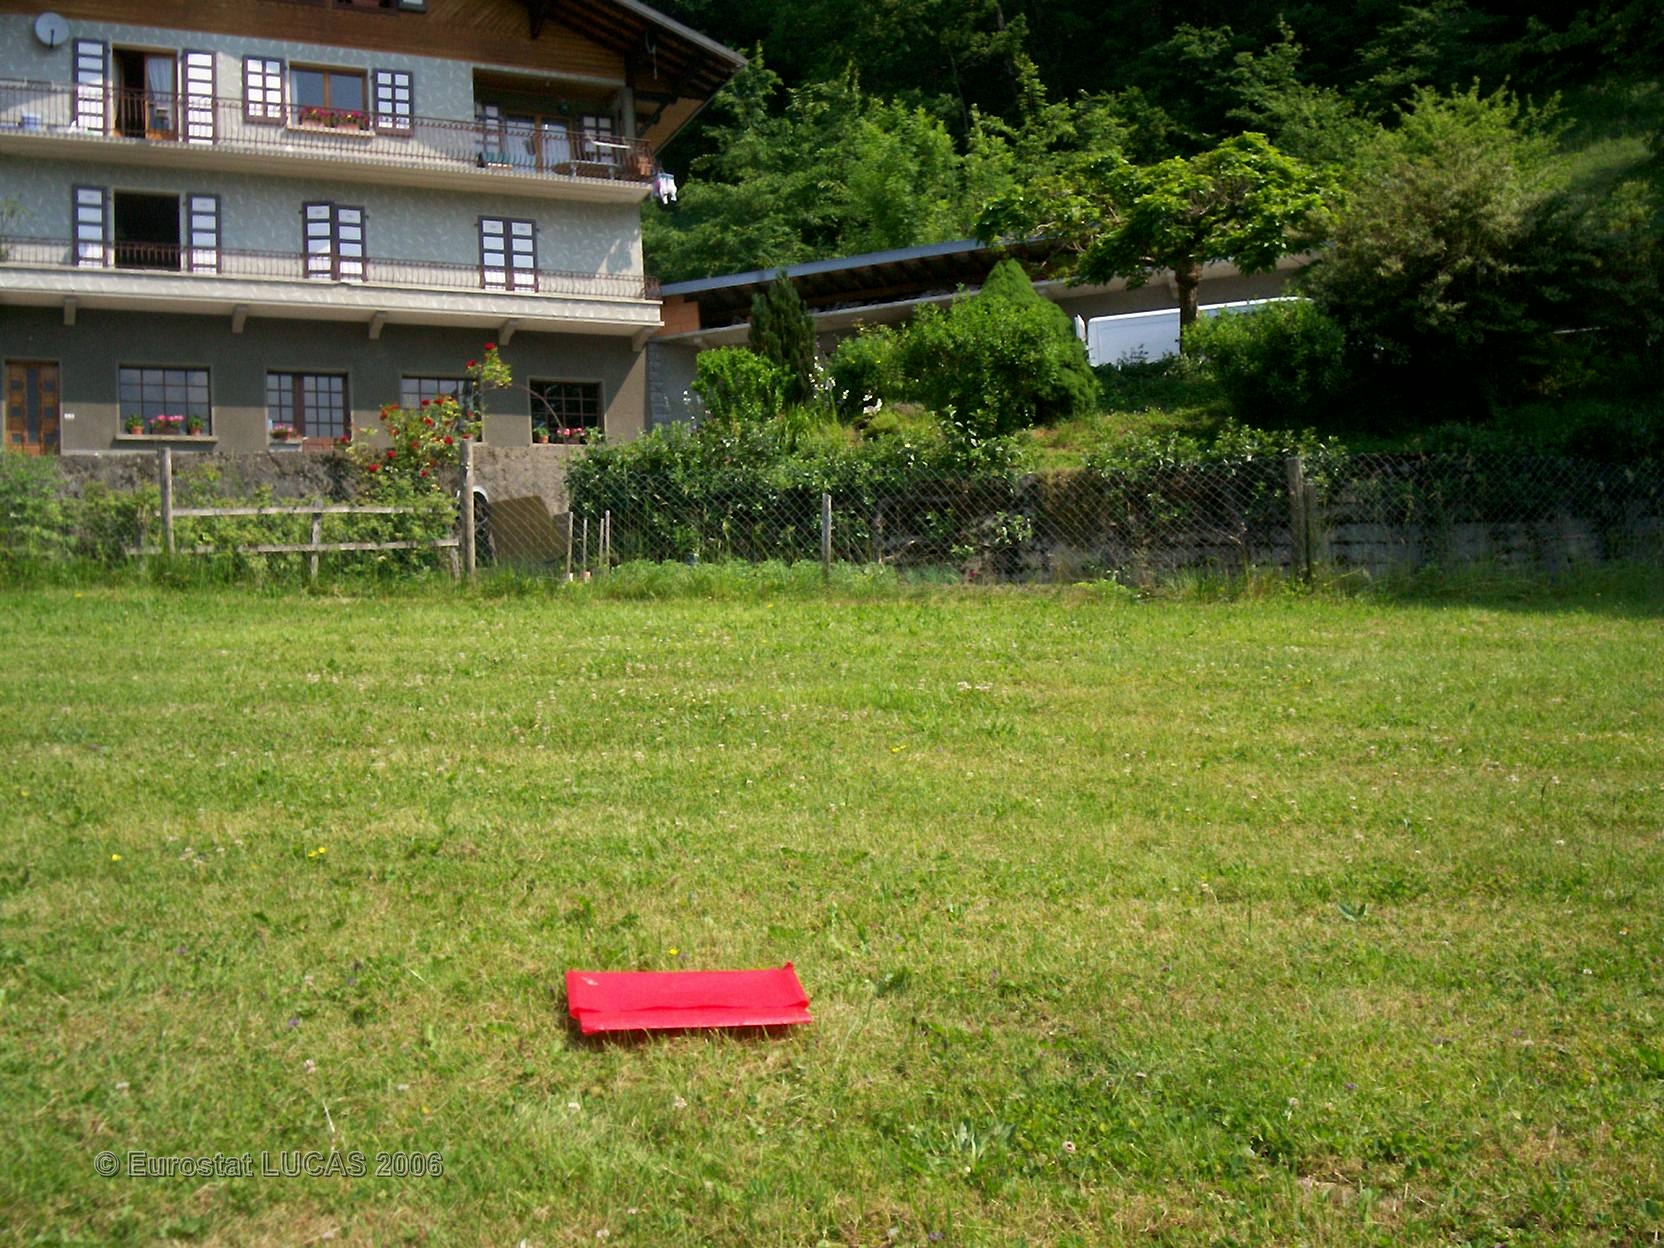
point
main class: Grassland
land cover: Grassland with sparse tree/shrub cover
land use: Agriculture (excluding fallow land and kitchen gardens)
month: June
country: FR
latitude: 46.1006
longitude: 6.6532
